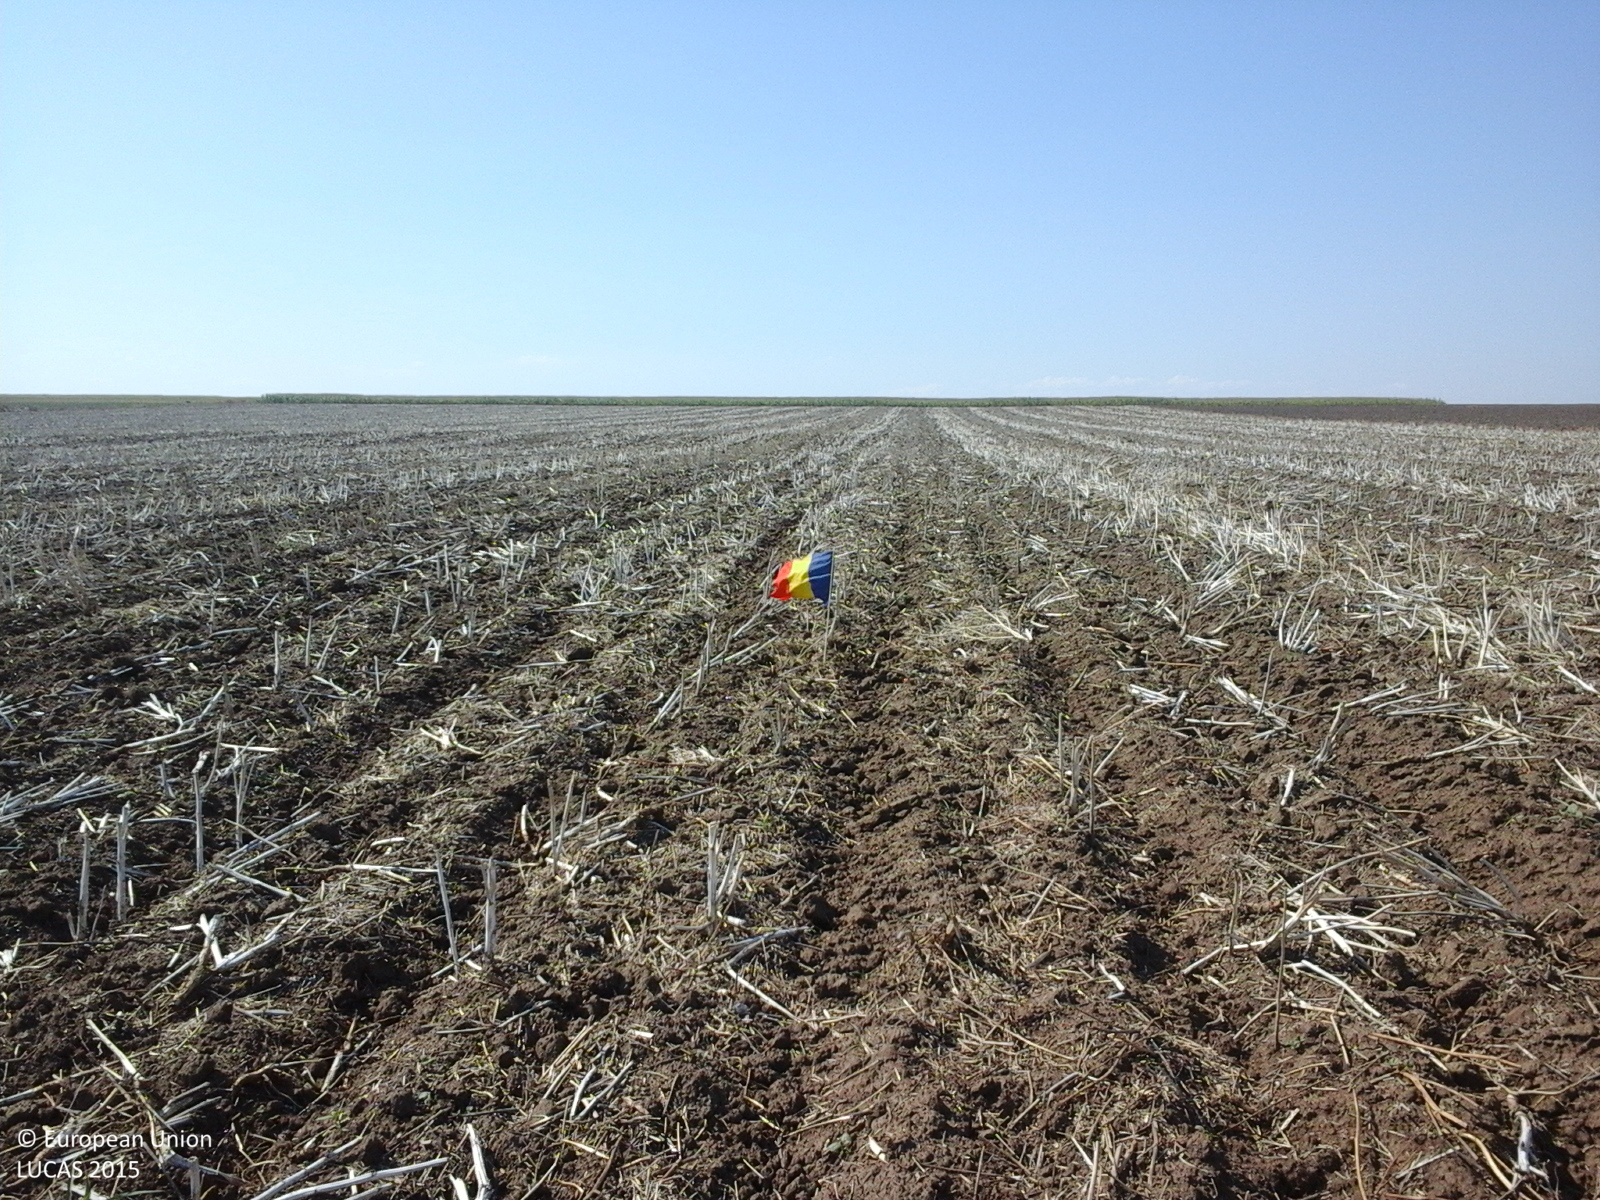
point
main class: Cropland
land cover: Rape and turnip rape
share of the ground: 10 - 25 %
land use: Agriculture (excluding fallow land and kitchen gardens)
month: August
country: RO
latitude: 44.2540
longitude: 28.4161
